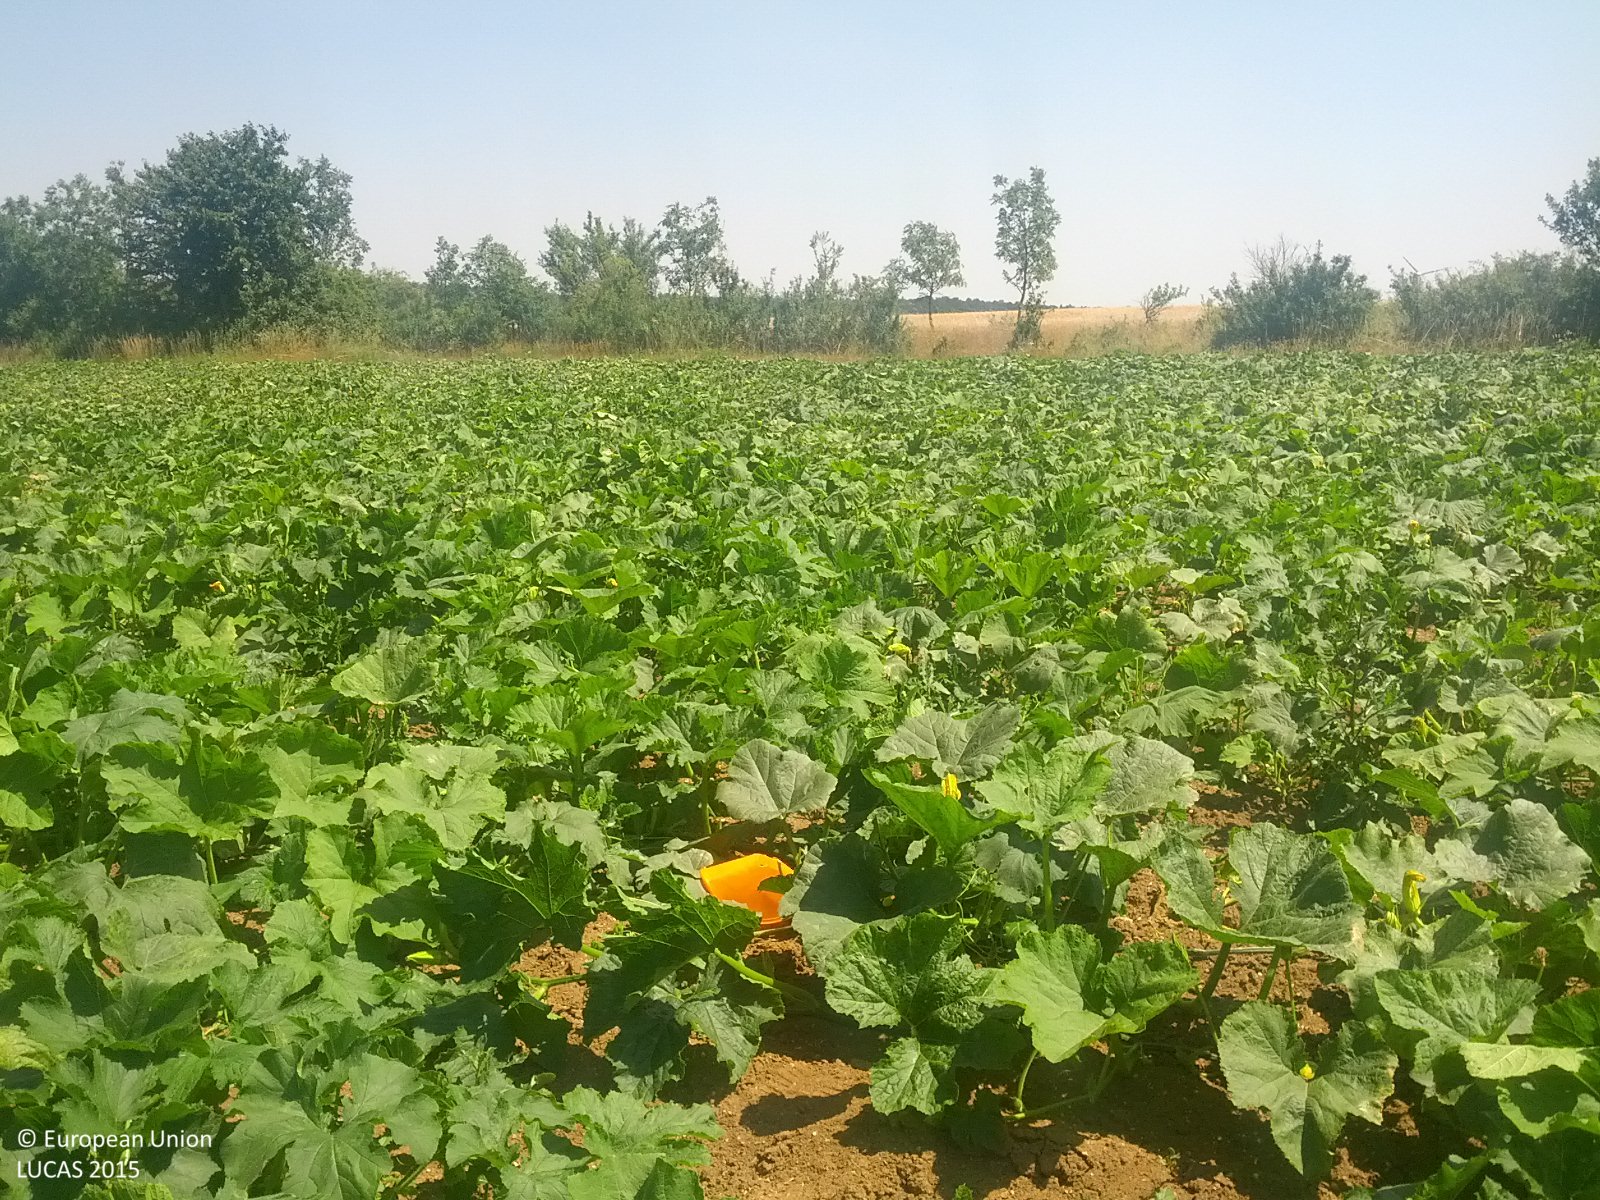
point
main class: Cropland
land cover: Other fresh vegetables
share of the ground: > 75 %
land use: Agriculture (excluding fallow land and kitchen gardens)
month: July
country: AT
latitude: 48.5327
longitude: 16.5744
